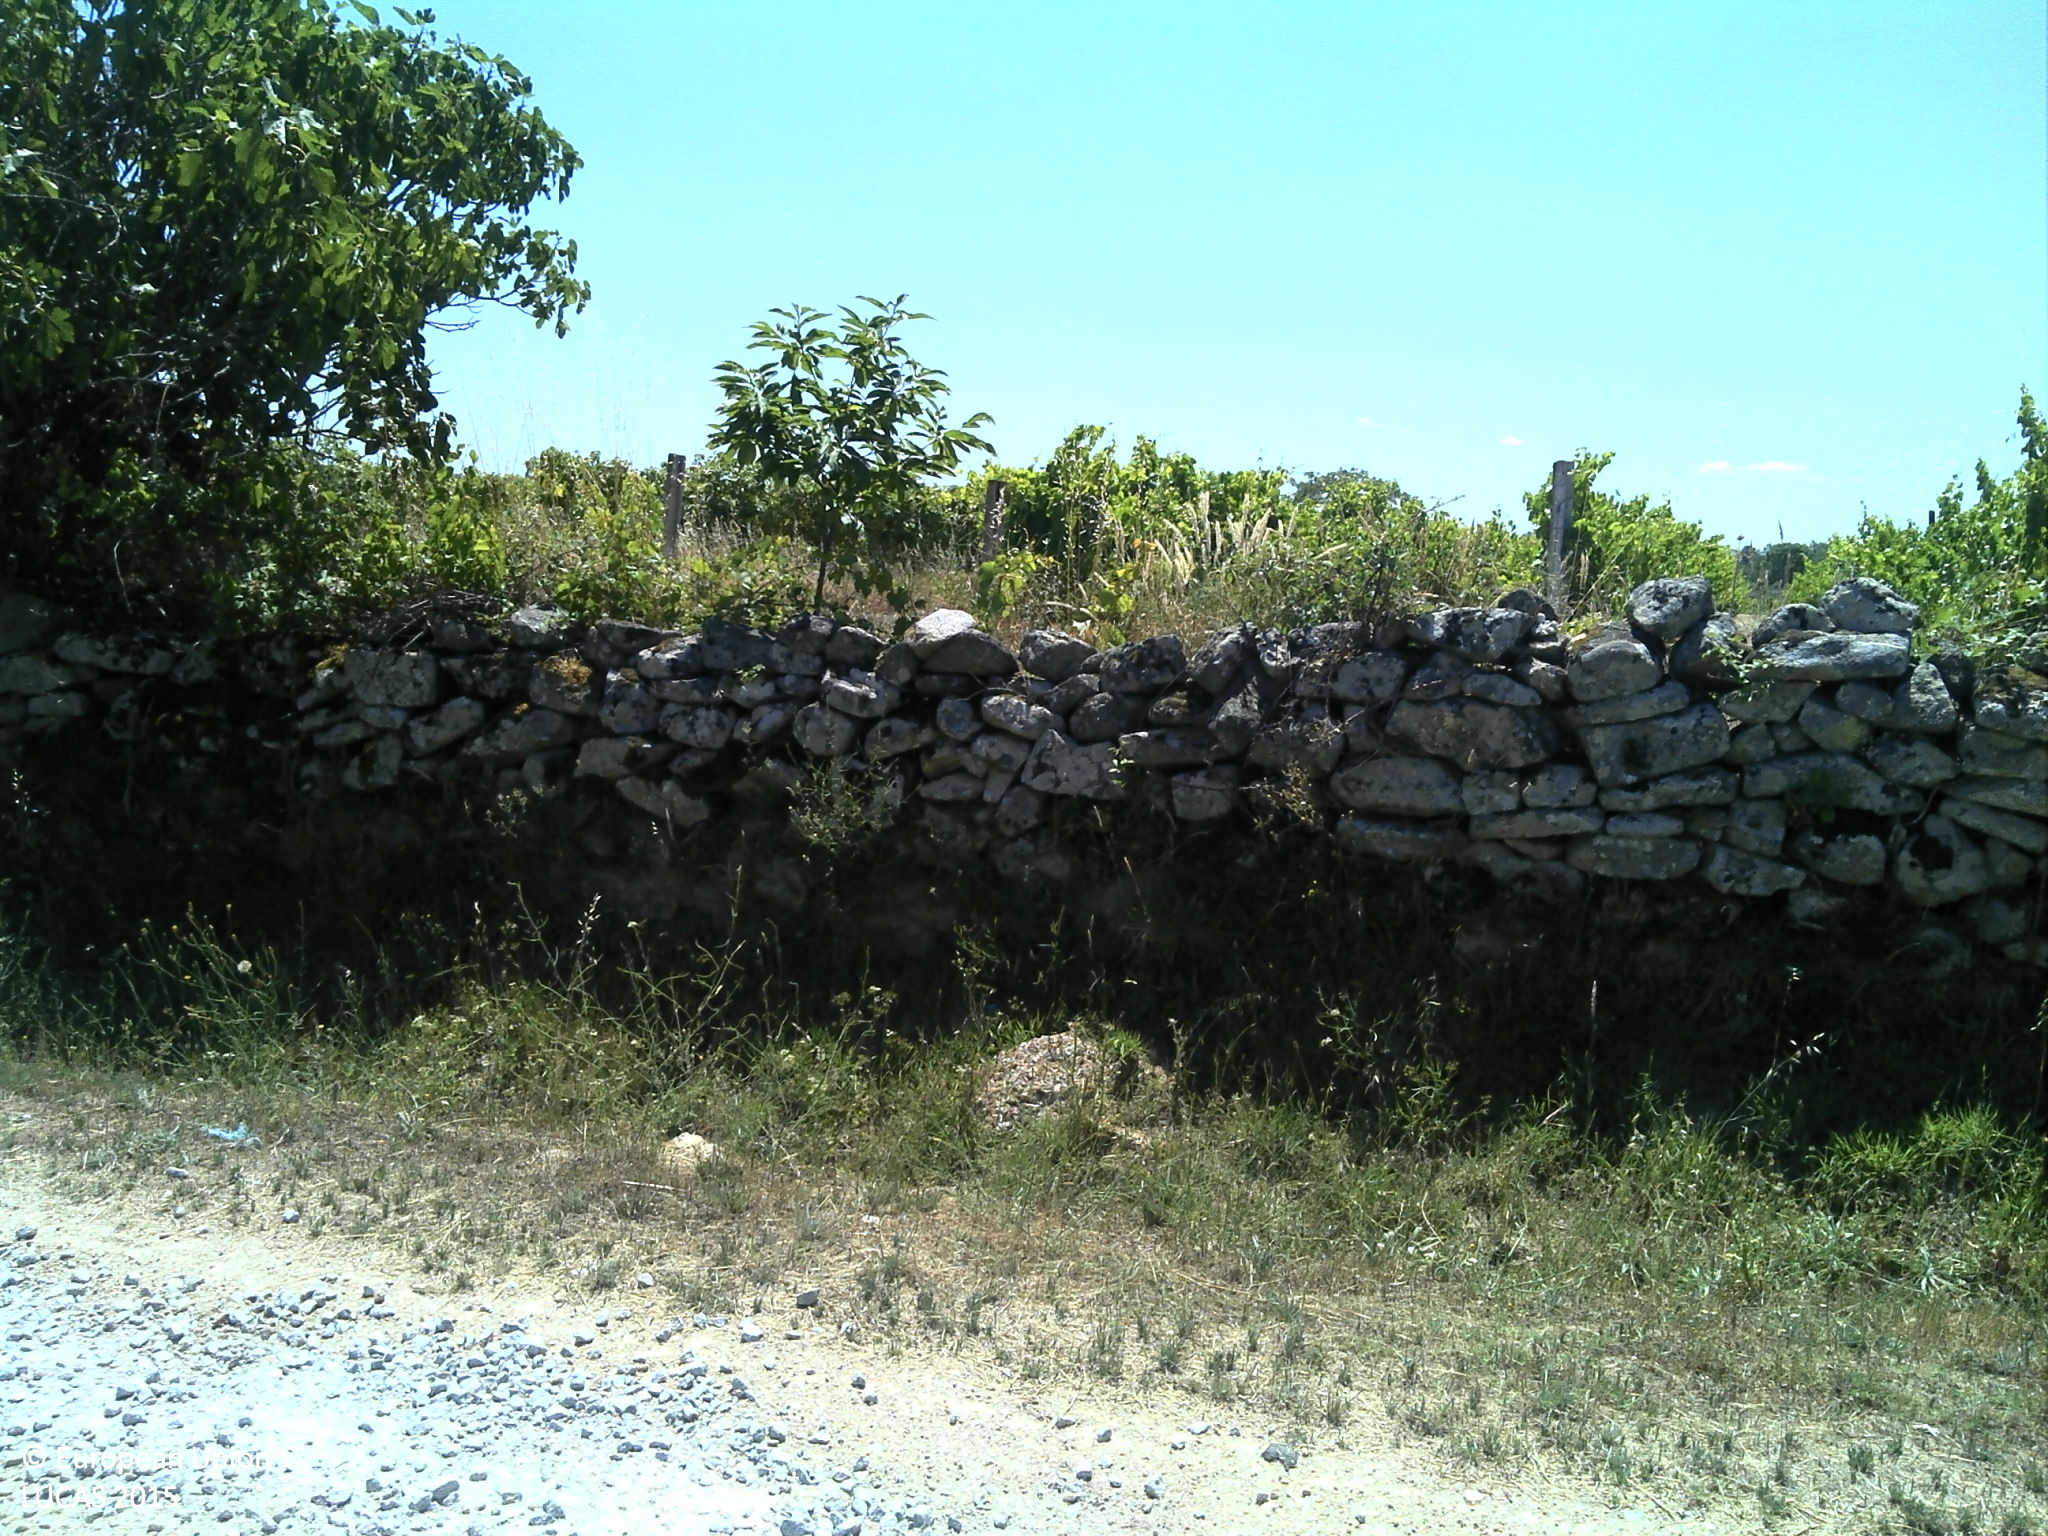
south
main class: Grassland
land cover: Grassland without tree/shrub cover
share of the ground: > 75 %
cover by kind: herbaceous plants 80 %, unconsolidated bare surface 20 %
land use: Agriculture (excluding fallow land and kitchen gardens)
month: June
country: PT
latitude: 40.7327
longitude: -7.1692
